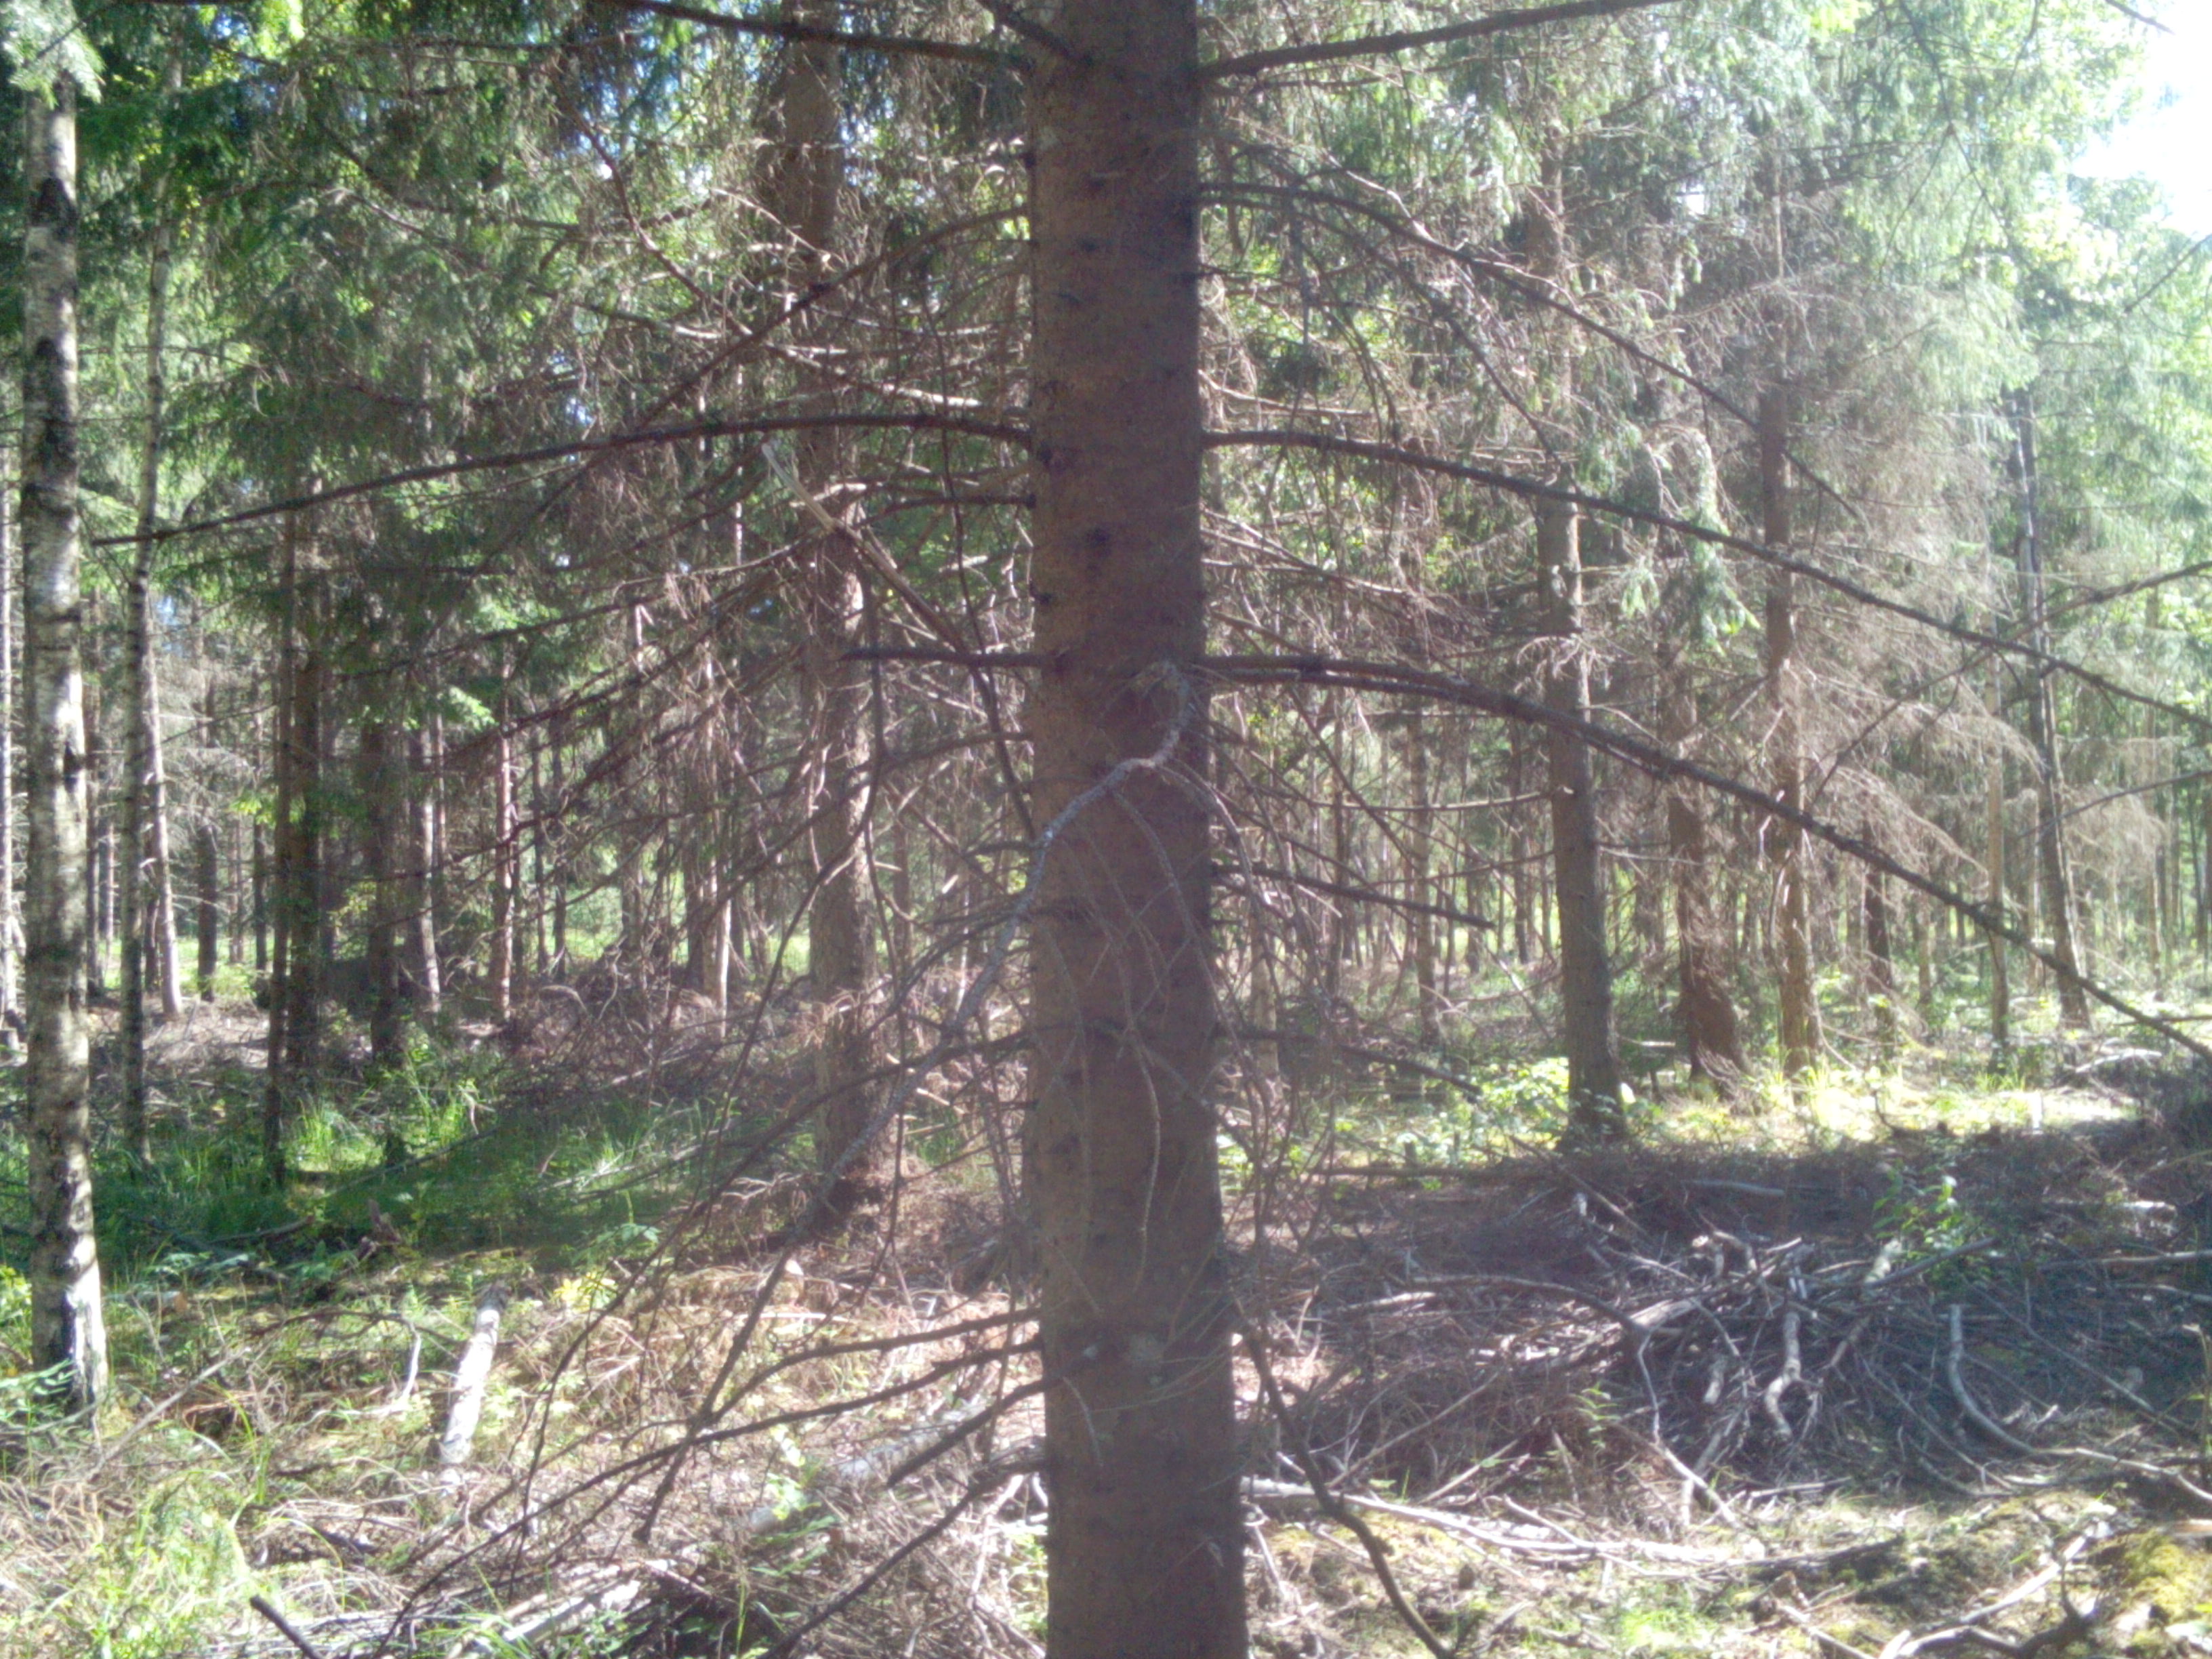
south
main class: Woodland
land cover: Spruce dominated mixed woodland
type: hemiboreal forest and nemoral coniferous forest and mixed broadleaved-coniferous forest
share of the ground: > 75 %
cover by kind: coniferous forest trees 50 %, broadleaved forest trees 35 %, herbaceous plants 5 %, lichens and mosses 5 %, unconsolidated bare surface 5 %
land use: Forestry
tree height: > 5 m
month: July
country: LV
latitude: 56.5586
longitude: 22.1072
